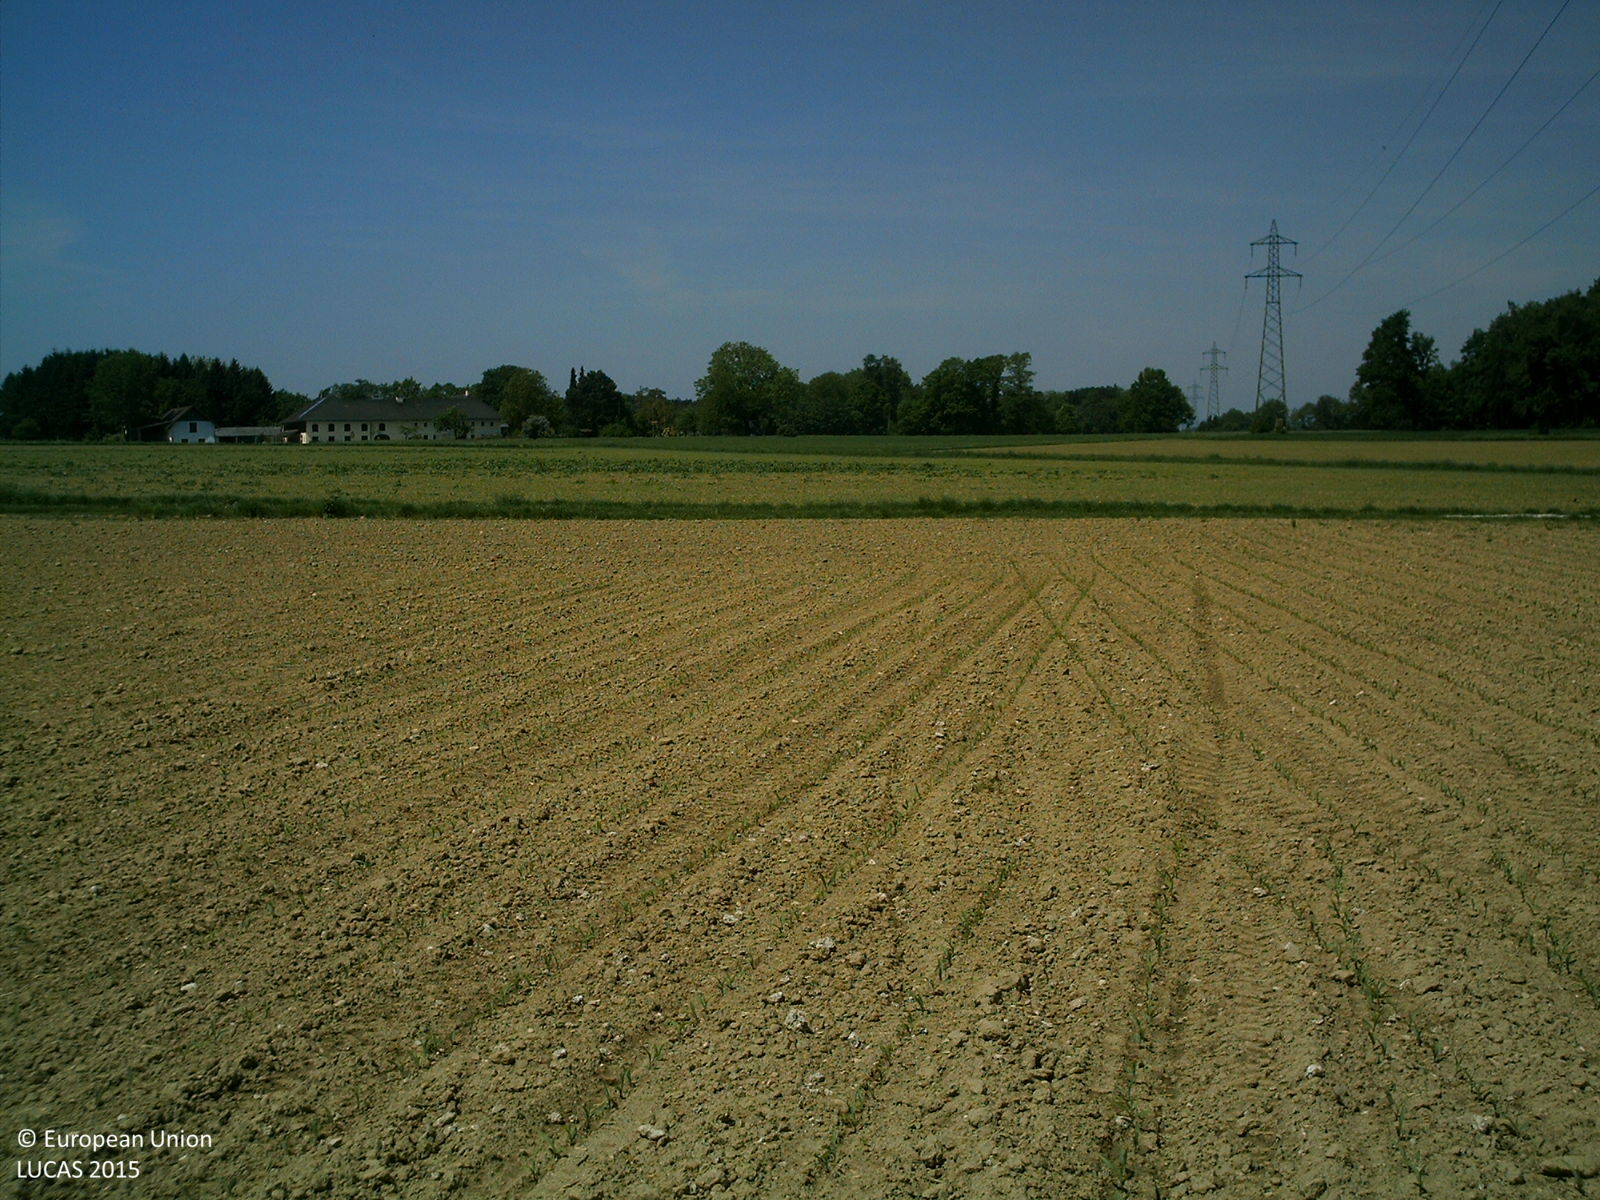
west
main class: Cropland
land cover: Maize
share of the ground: < 10 %
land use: Agriculture (excluding fallow land and kitchen gardens)
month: May
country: AT
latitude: 48.0056
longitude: 14.0341
